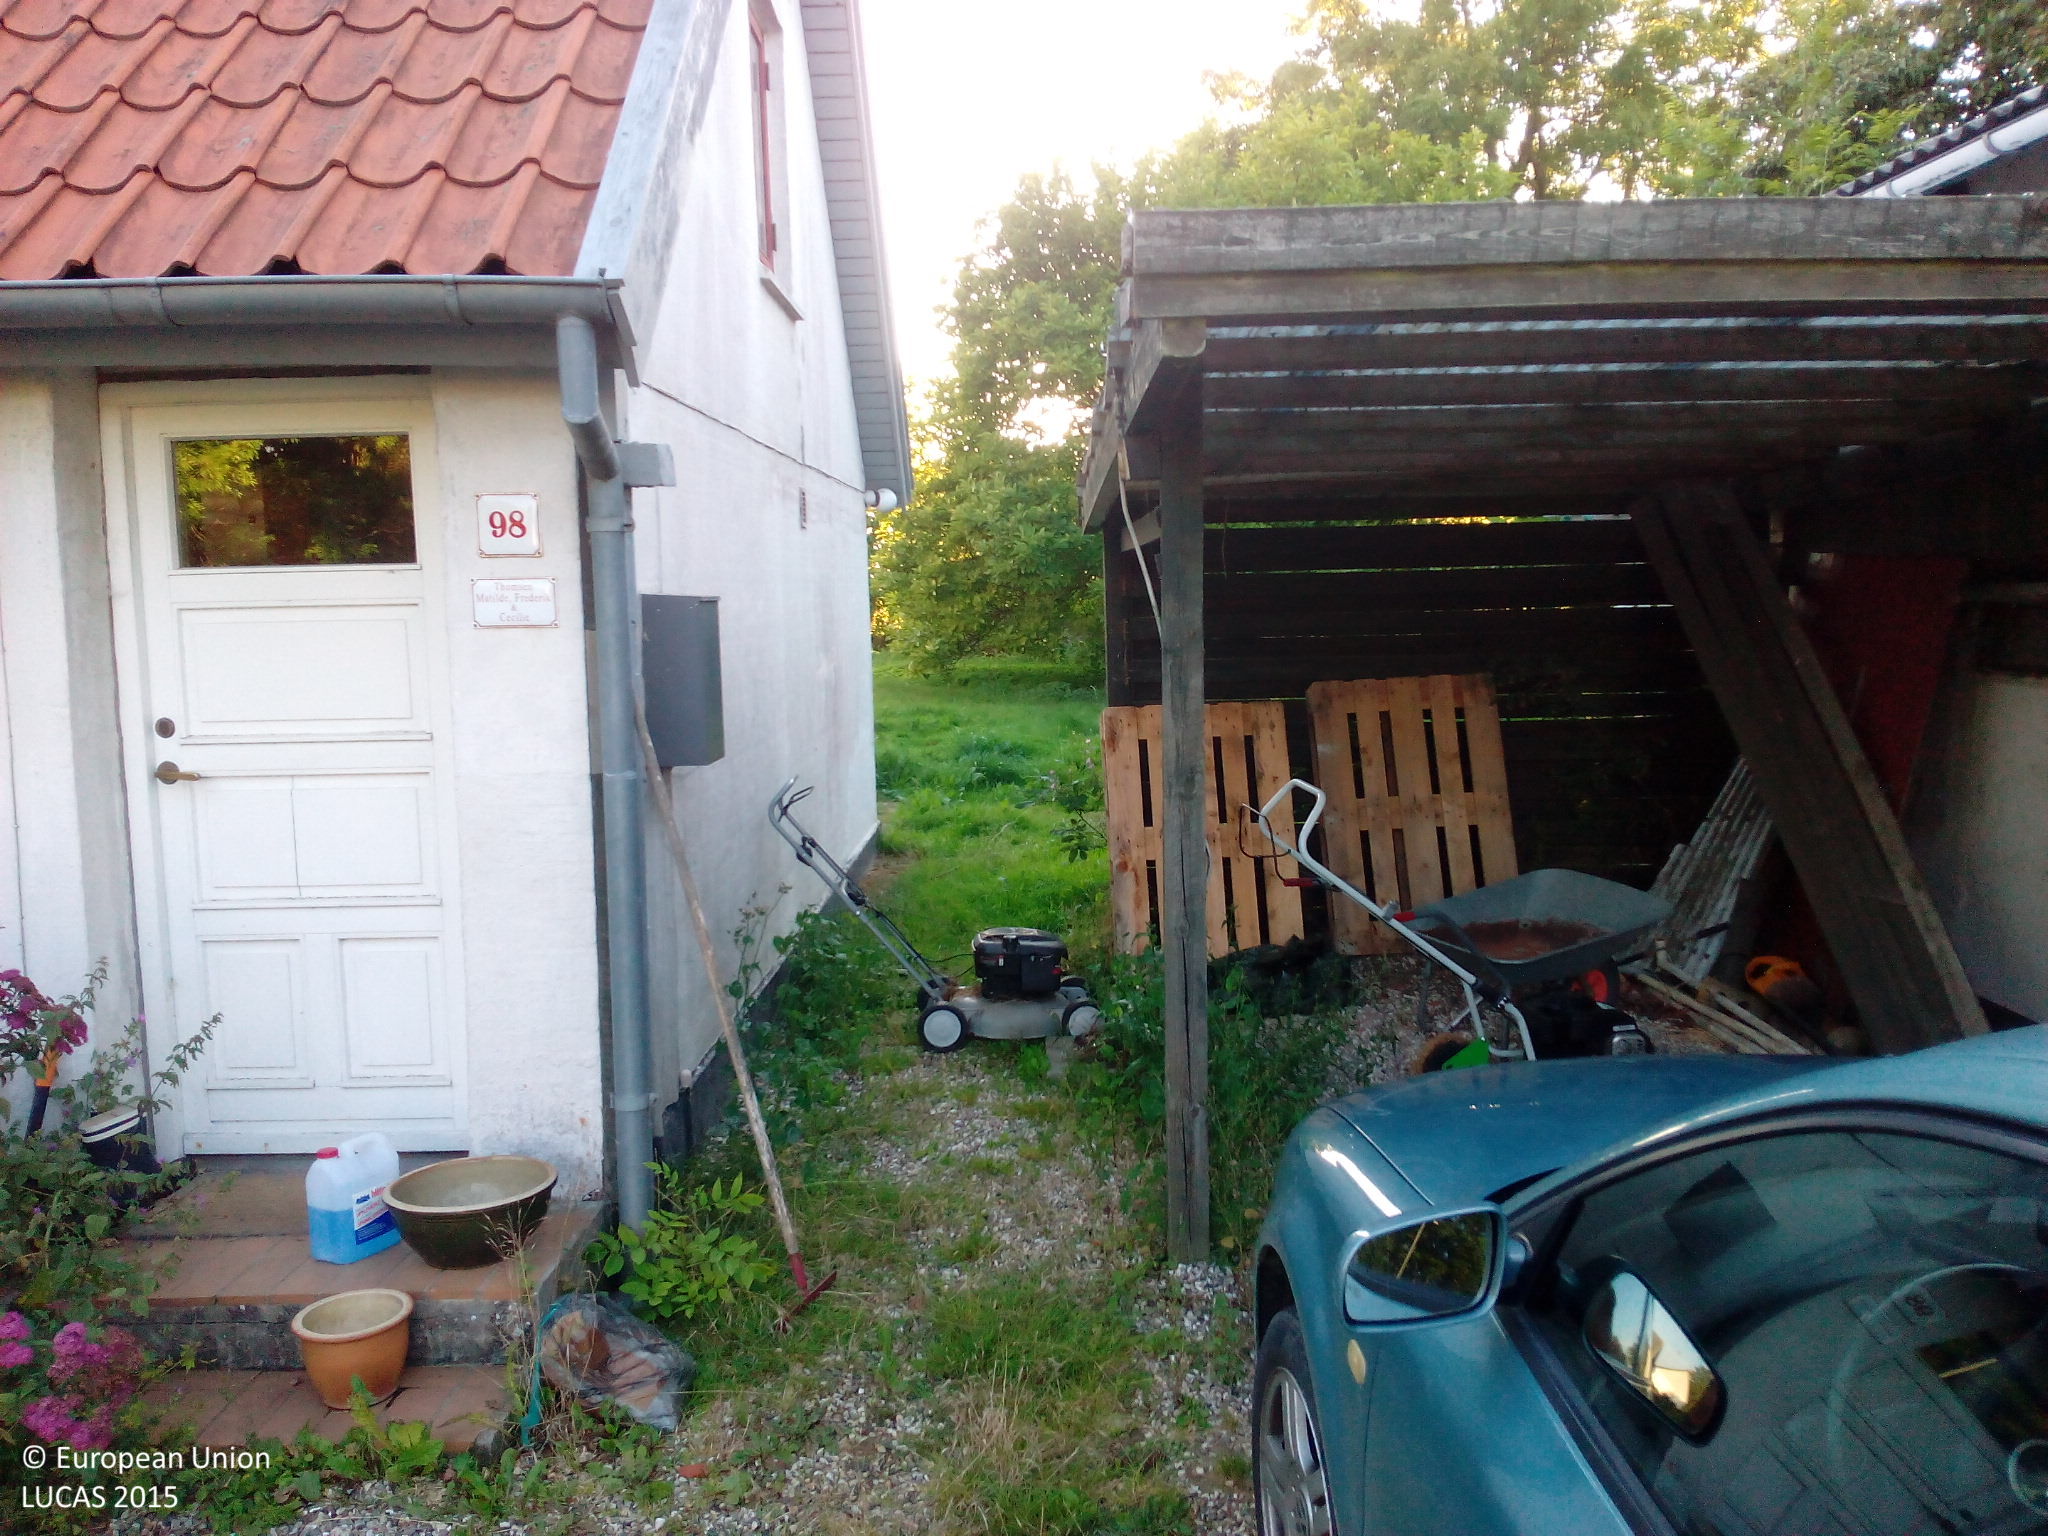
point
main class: Cropland
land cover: Common wheat
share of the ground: > 75 %
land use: Agriculture (excluding fallow land and kitchen gardens)
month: August
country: DK
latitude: 55.5640
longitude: 11.7902
